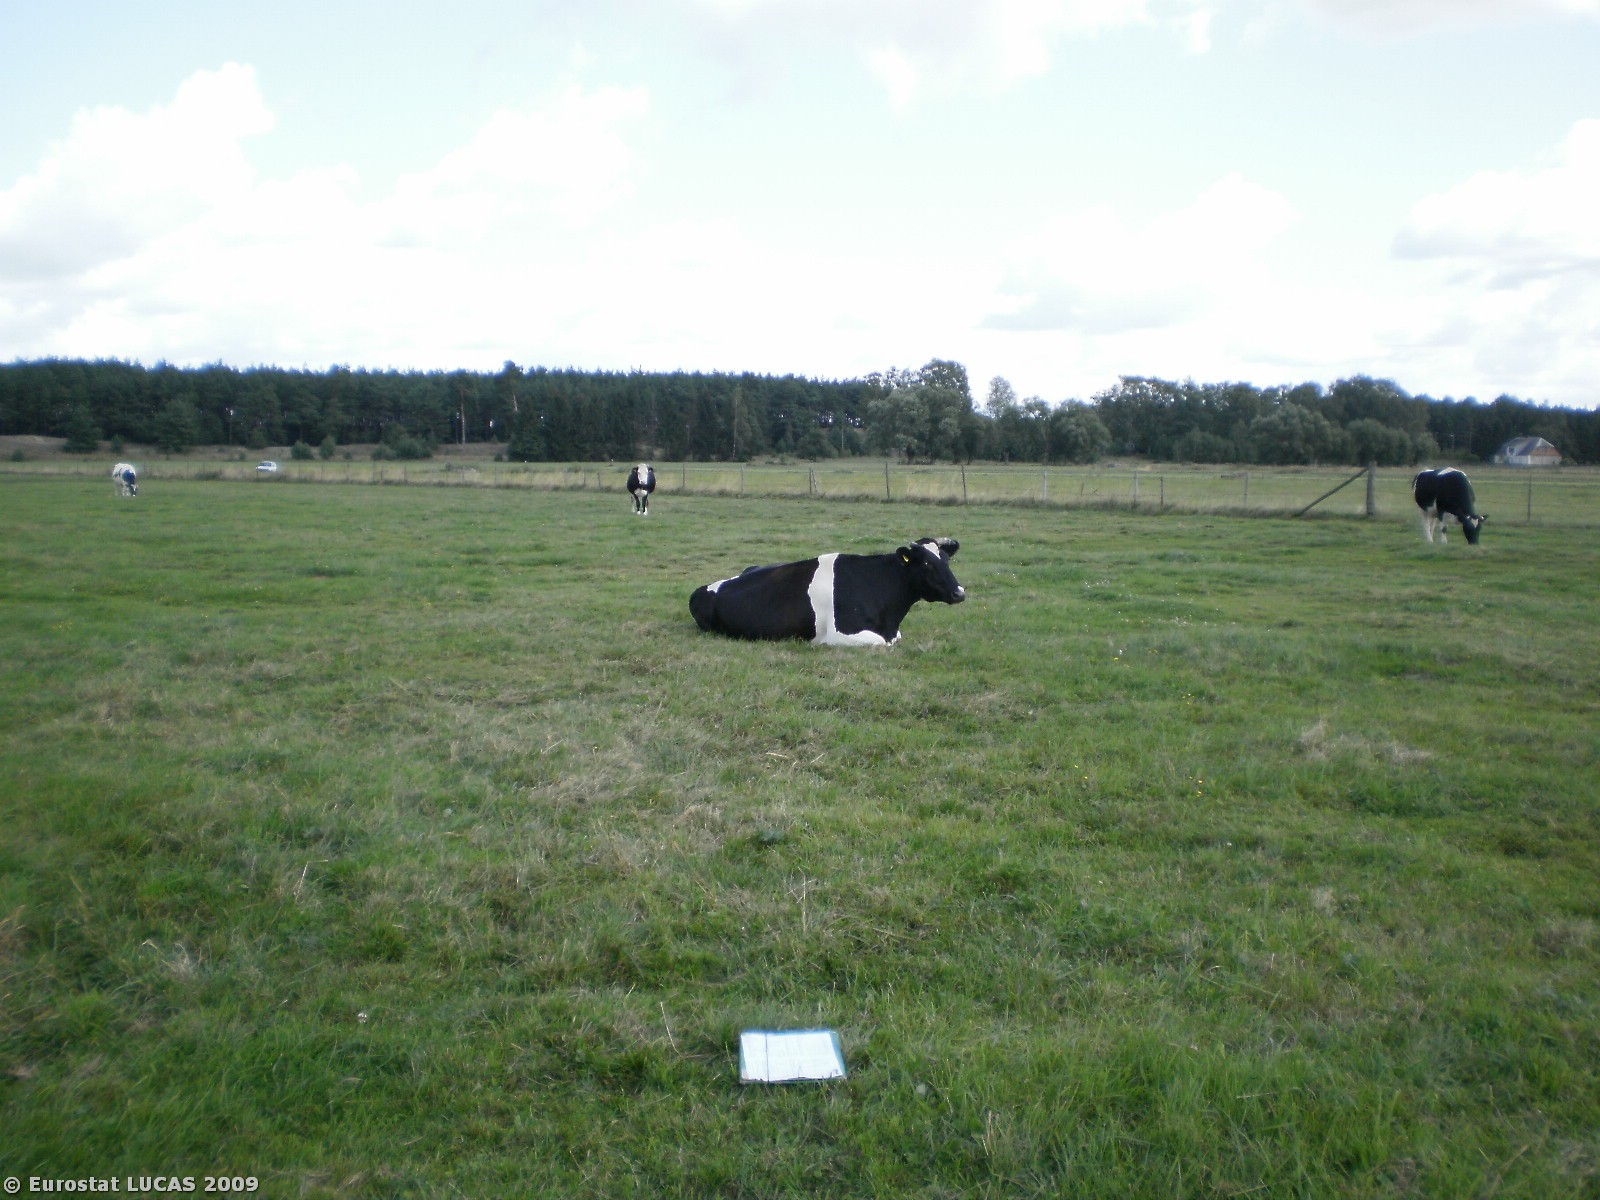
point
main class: Grassland
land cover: Grassland without tree/shrub cover
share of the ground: > 75 %
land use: Agriculture (excluding fallow land and kitchen gardens)
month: August
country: PL
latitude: 53.1309
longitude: 21.2414
